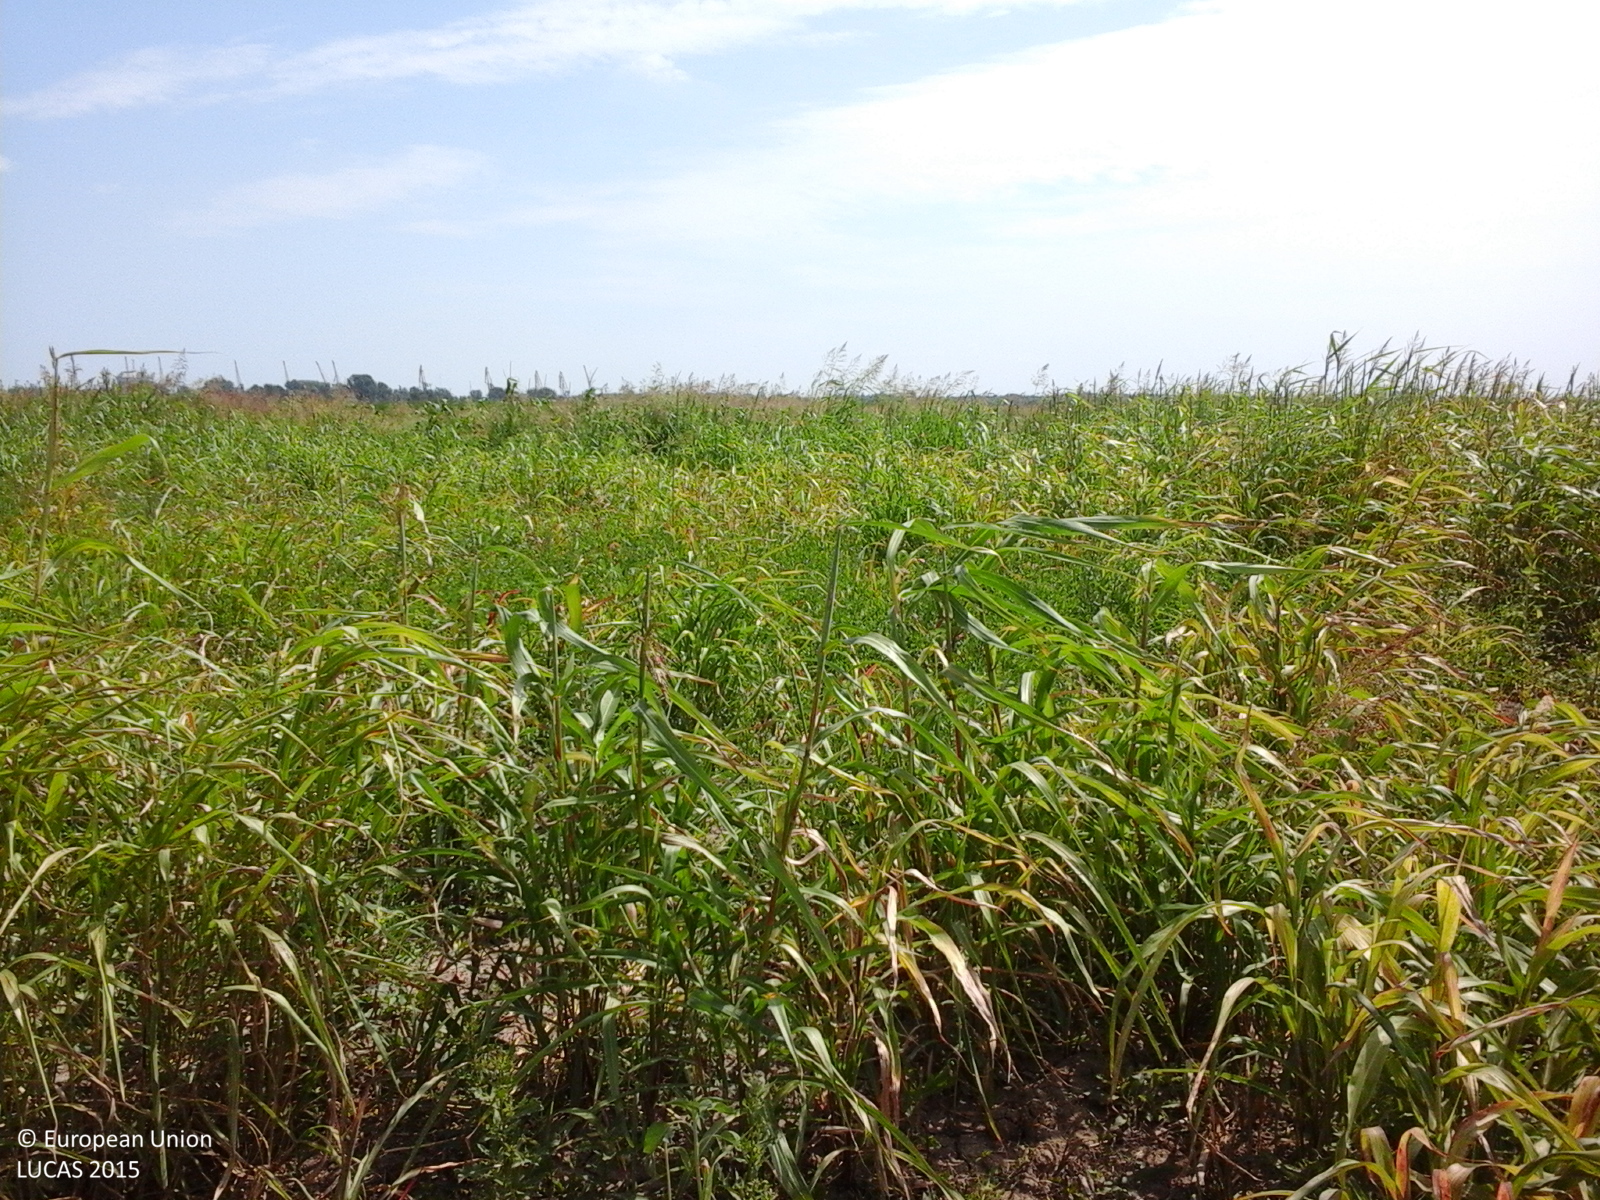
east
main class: Grassland
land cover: Spontaneously vegetated surfaces
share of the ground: > 75 %
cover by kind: herbaceous plants 100 %
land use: Fallow land
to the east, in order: Spontaneously vegetated surfaces; Ditches and canals; Spontaneously vegetated surfaces; Sunflower
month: August
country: RO
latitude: 45.3280
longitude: 28.8089
